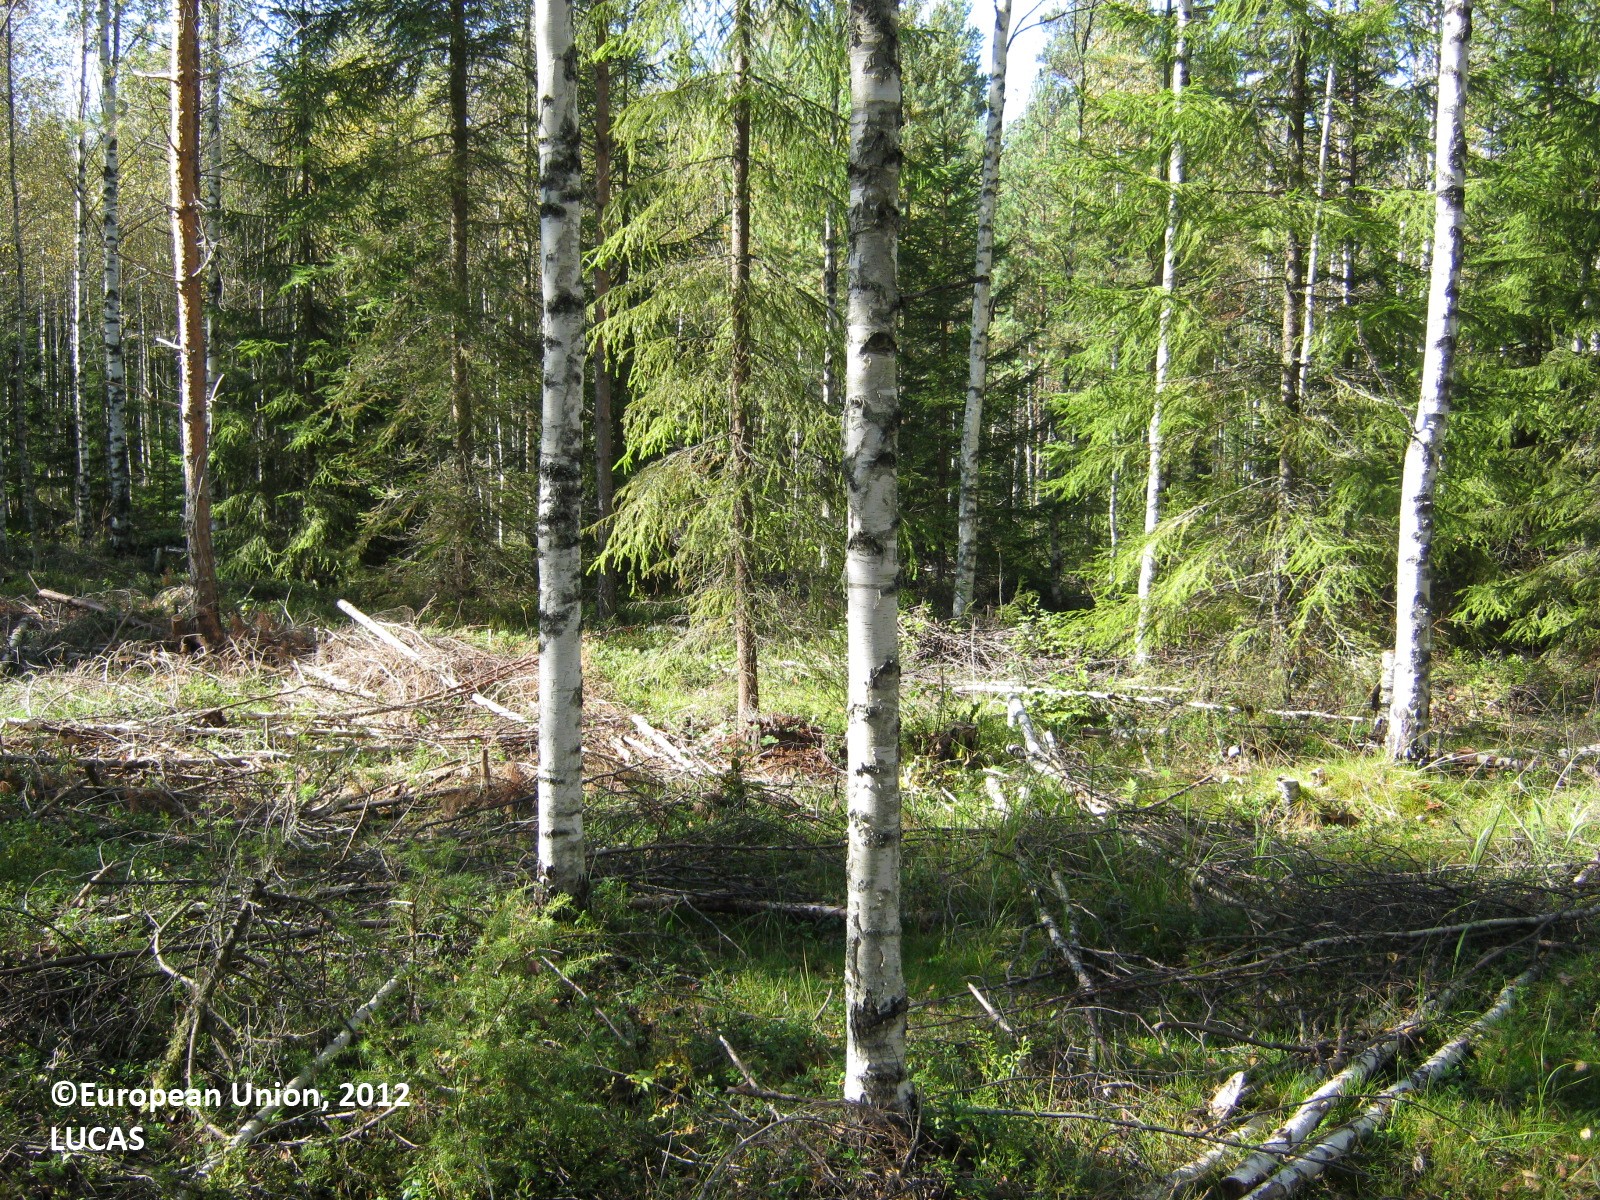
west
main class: Woodland
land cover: Pine dominated coniferous woodland
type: boreal forest
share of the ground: > 75 %
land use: Forestry
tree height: > 5 m
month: September
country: FI
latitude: 60.9535
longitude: 27.8647
